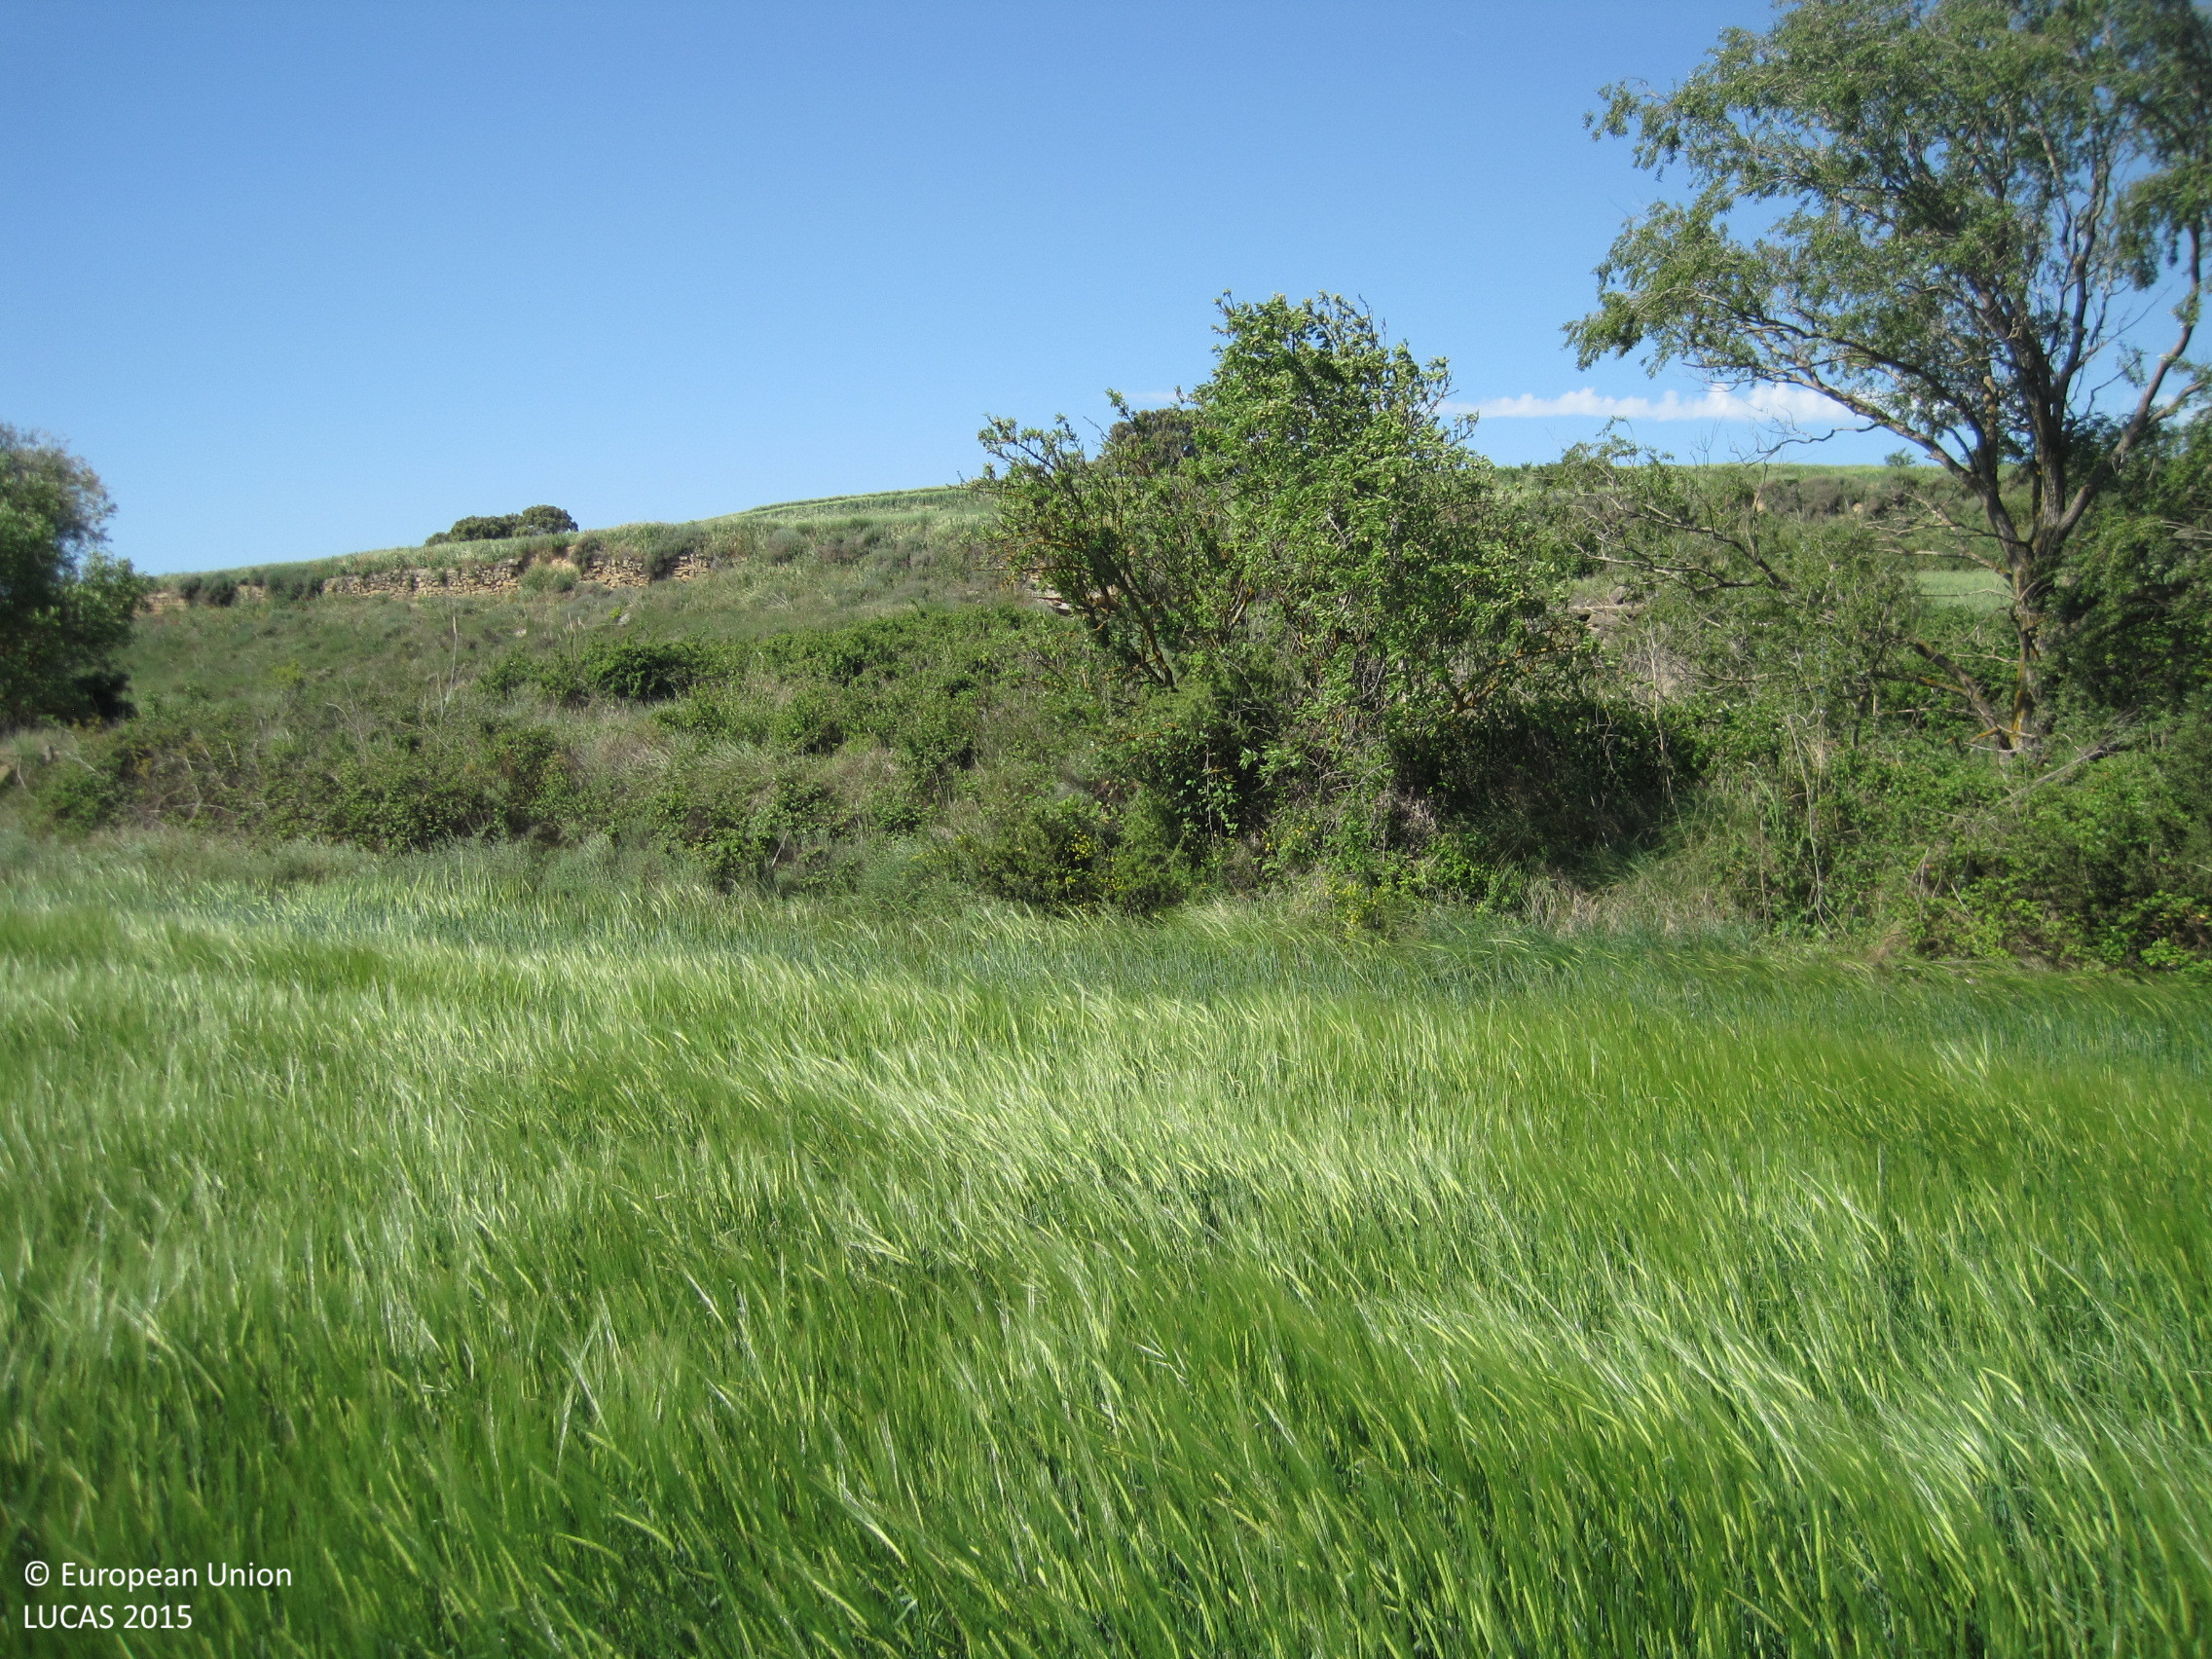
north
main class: Cropland
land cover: Barley
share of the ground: > 75 %
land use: Agriculture (excluding fallow land and kitchen gardens)
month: May
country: ES
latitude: 42.5397
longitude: -1.6898
